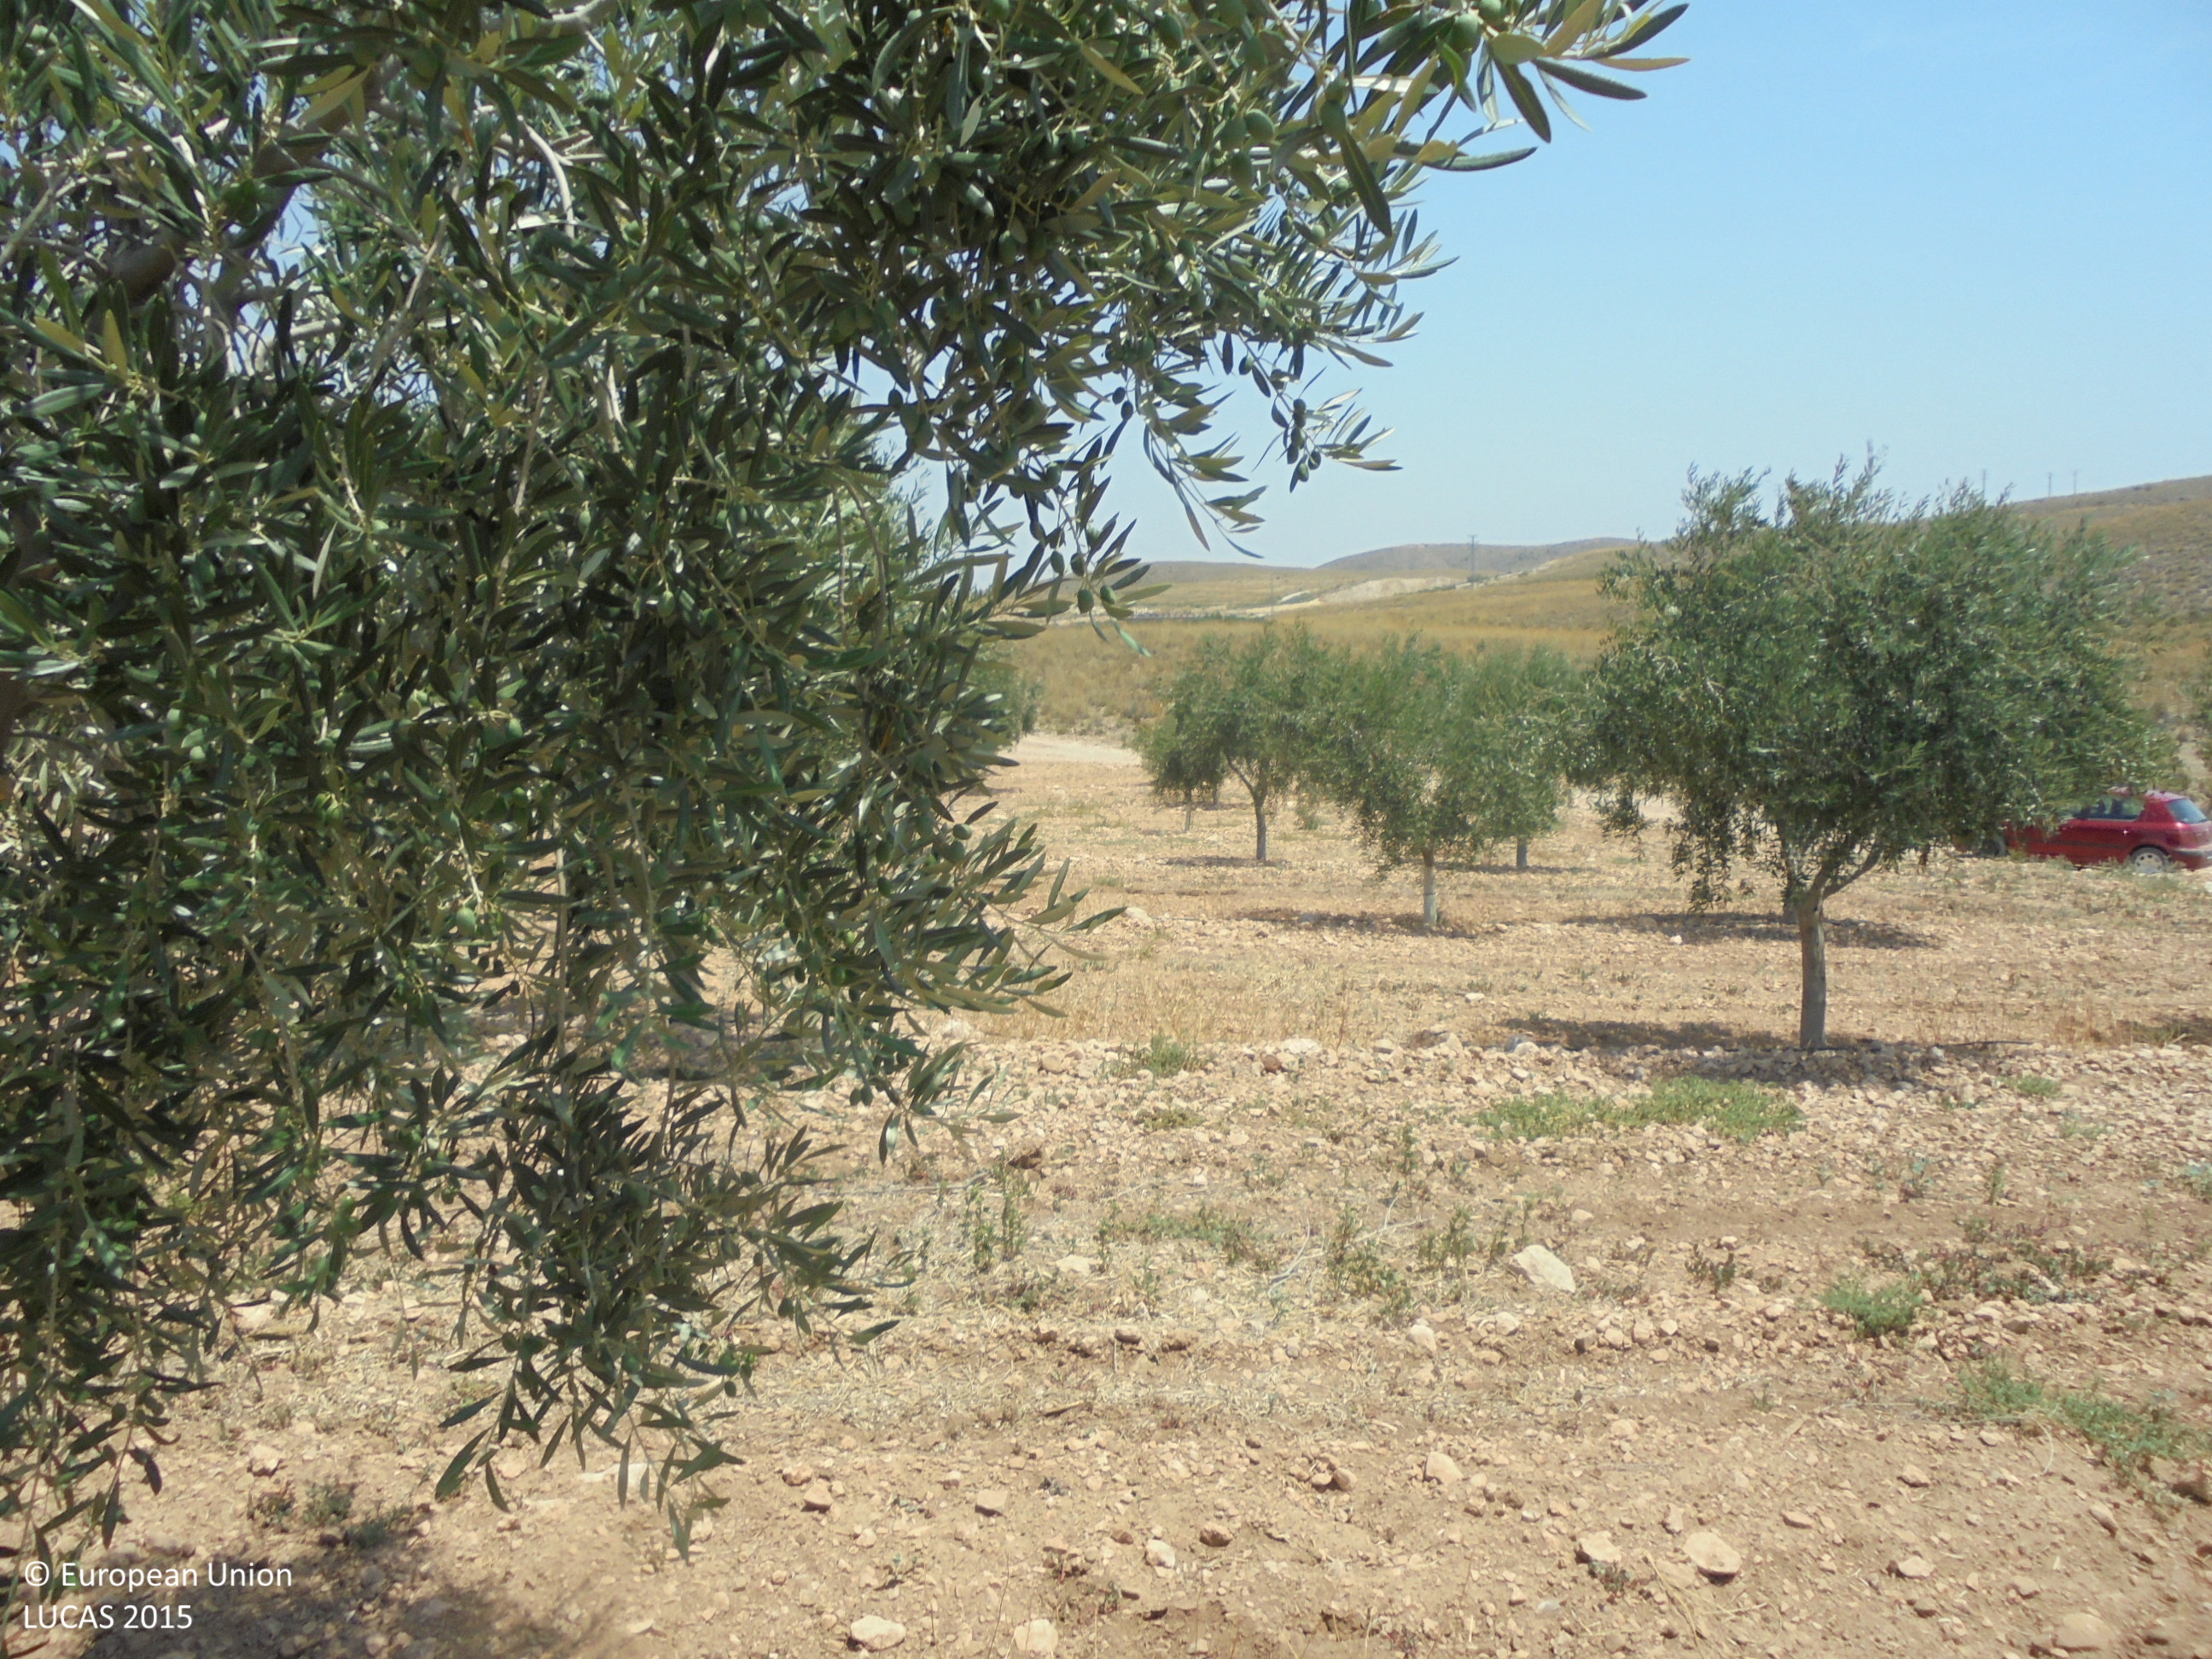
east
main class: Cropland
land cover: Olive groves
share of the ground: 25 - 50 %
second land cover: Spontaneously vegetated surfaces
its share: 50 - 75 %
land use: Agriculture (excluding fallow land and kitchen gardens)
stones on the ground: > 50 %
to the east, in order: Olive groves; Spontaneously vegetated surfaces; Tracks; Shrubland without tree cover; Tracks
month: July
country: ES
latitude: 38.5253
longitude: -1.6818
